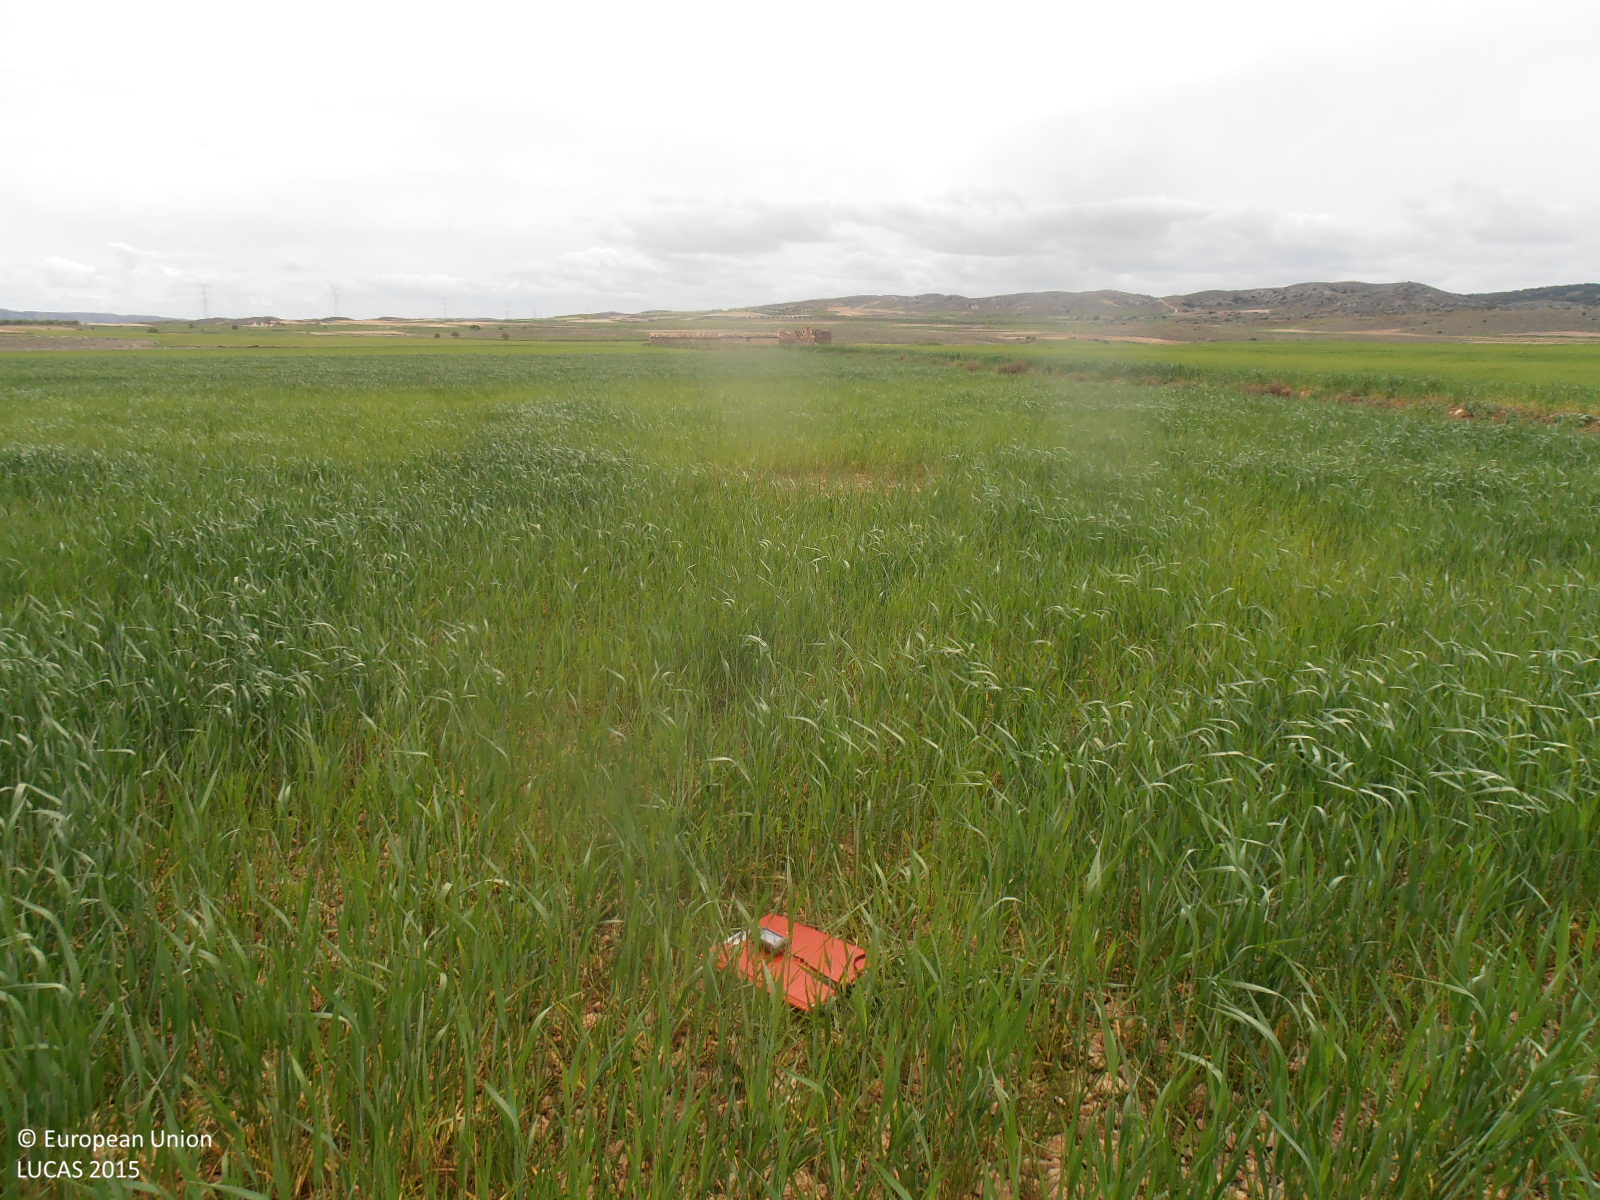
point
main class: Cropland
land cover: Durum wheat
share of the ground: > 75 %
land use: Agriculture (excluding fallow land and kitchen gardens)
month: April
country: ES
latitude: 41.1562
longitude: -0.8732
